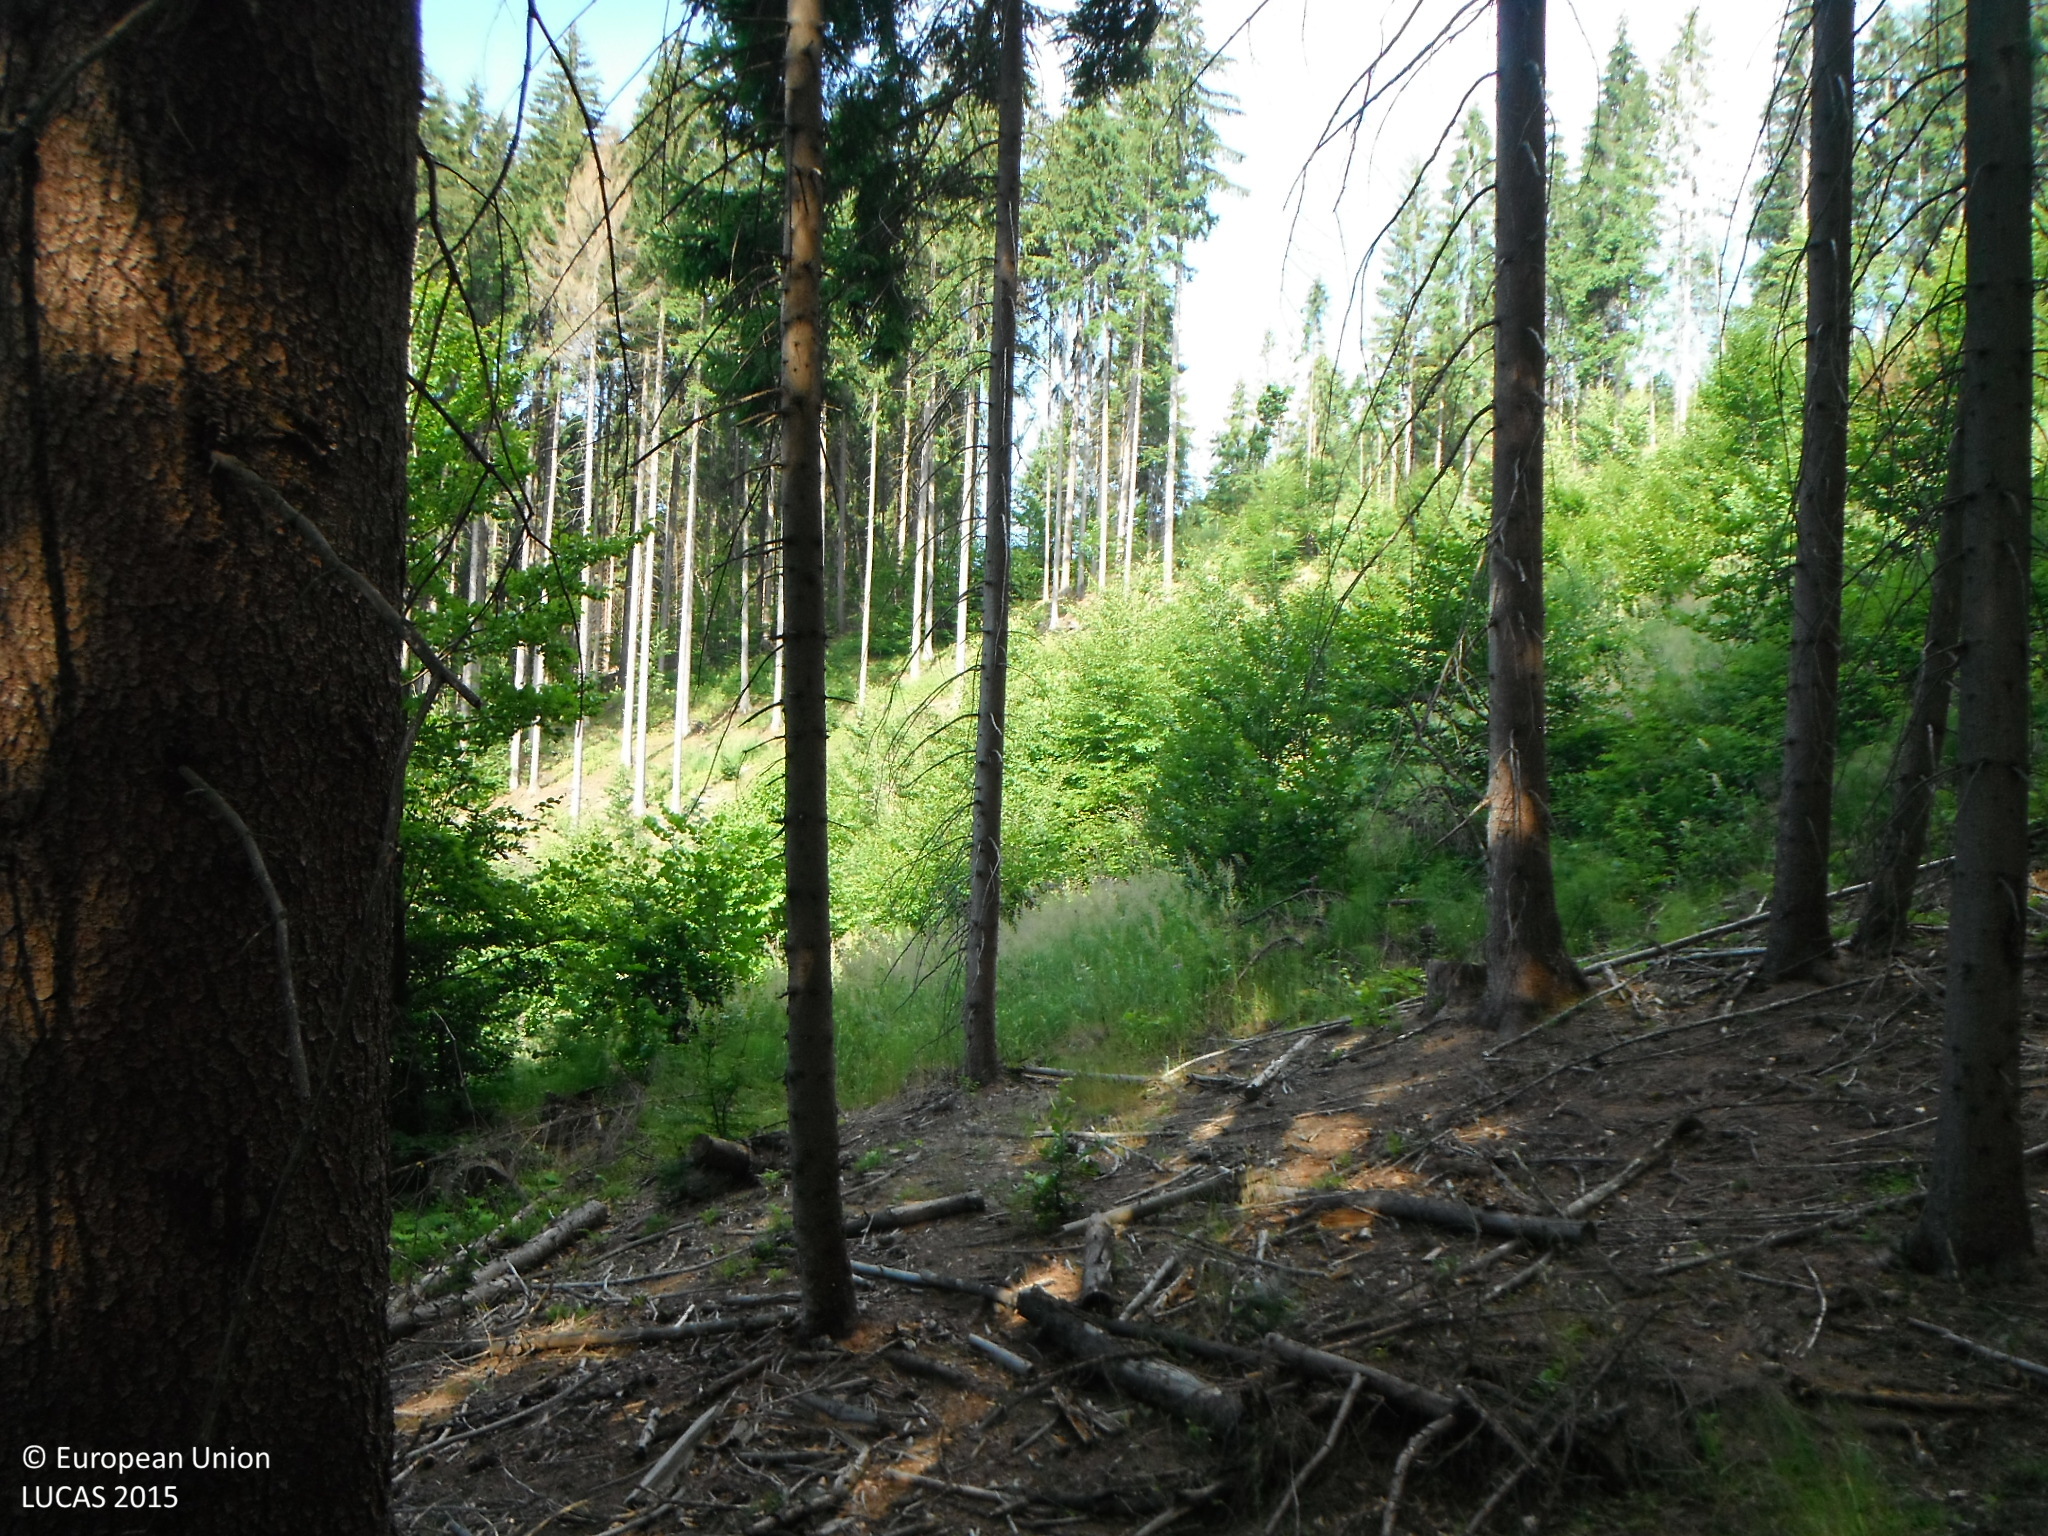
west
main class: Woodland
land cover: Spruce dominated coniferous woodland
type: alpine coniferous forest
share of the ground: > 75 %
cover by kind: coniferous forest trees 100 %
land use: Forestry
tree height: > 5 m
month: July
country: SK
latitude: 49.3496
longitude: 19.0945
